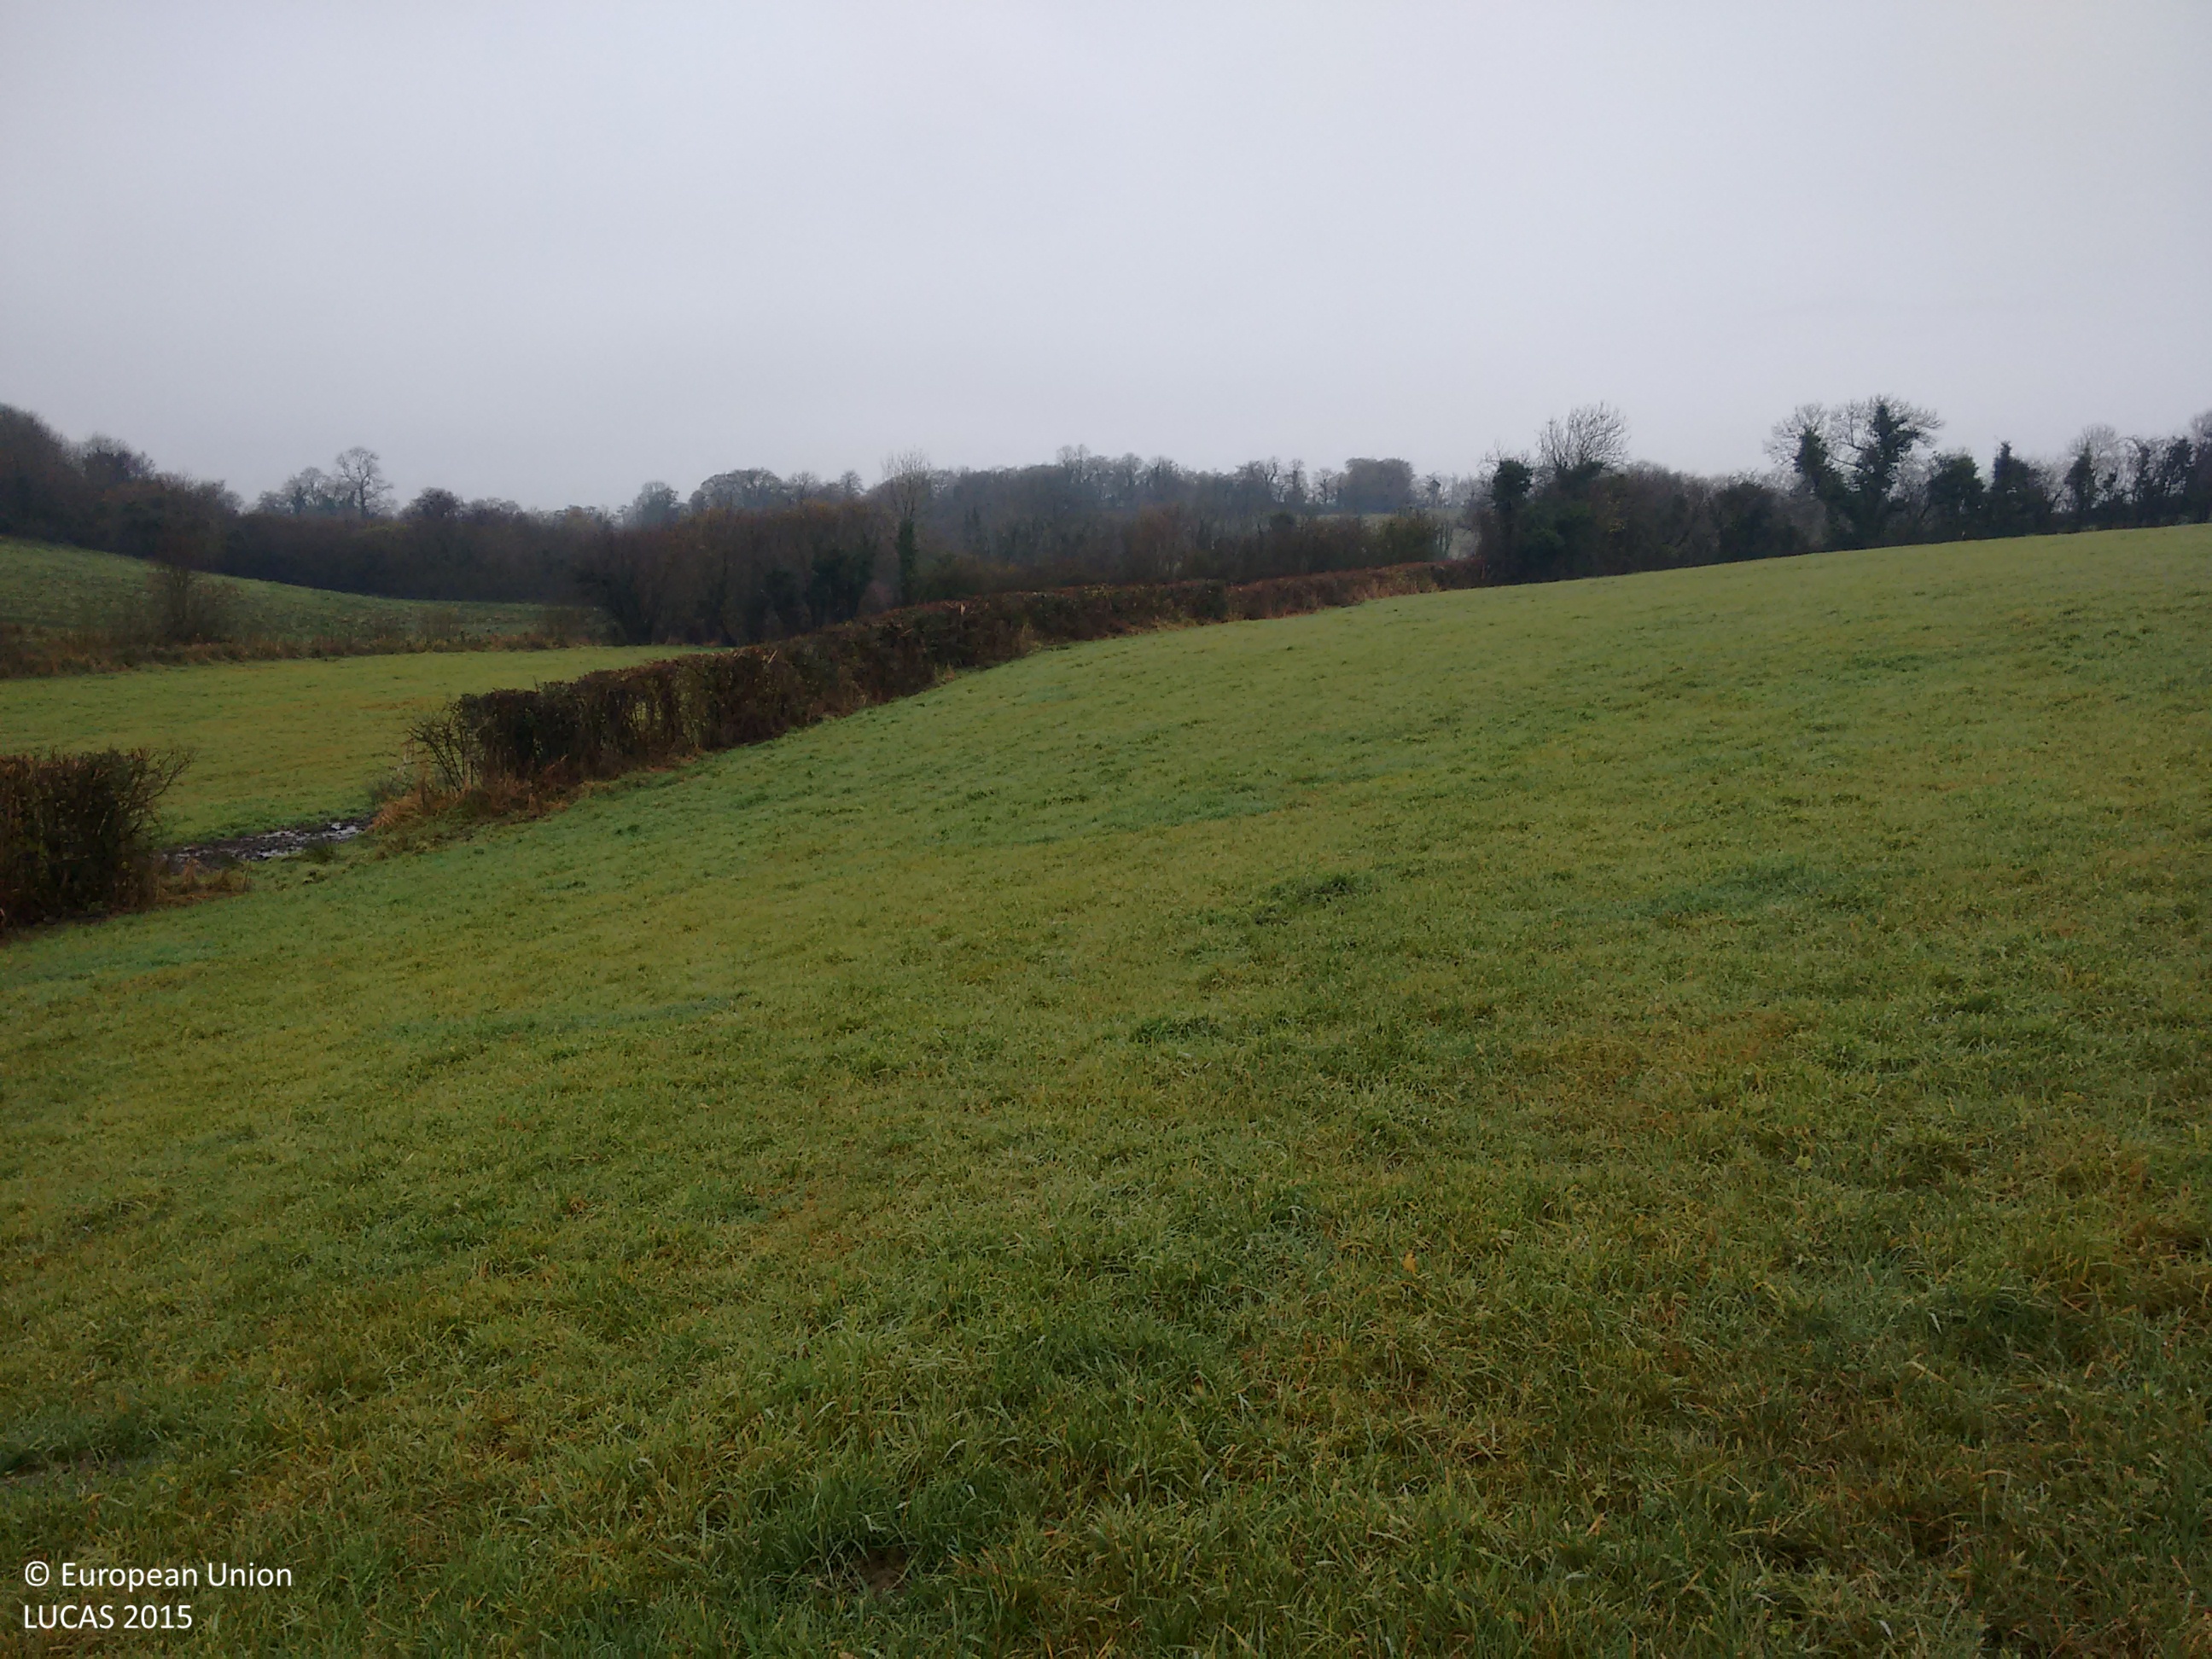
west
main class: Grassland
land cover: Grassland without tree/shrub cover
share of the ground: > 75 %
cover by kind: herbaceous plants 100 %
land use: Agriculture (excluding fallow land and kitchen gardens)
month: December
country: GB
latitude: 54.2094
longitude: -7.2758
